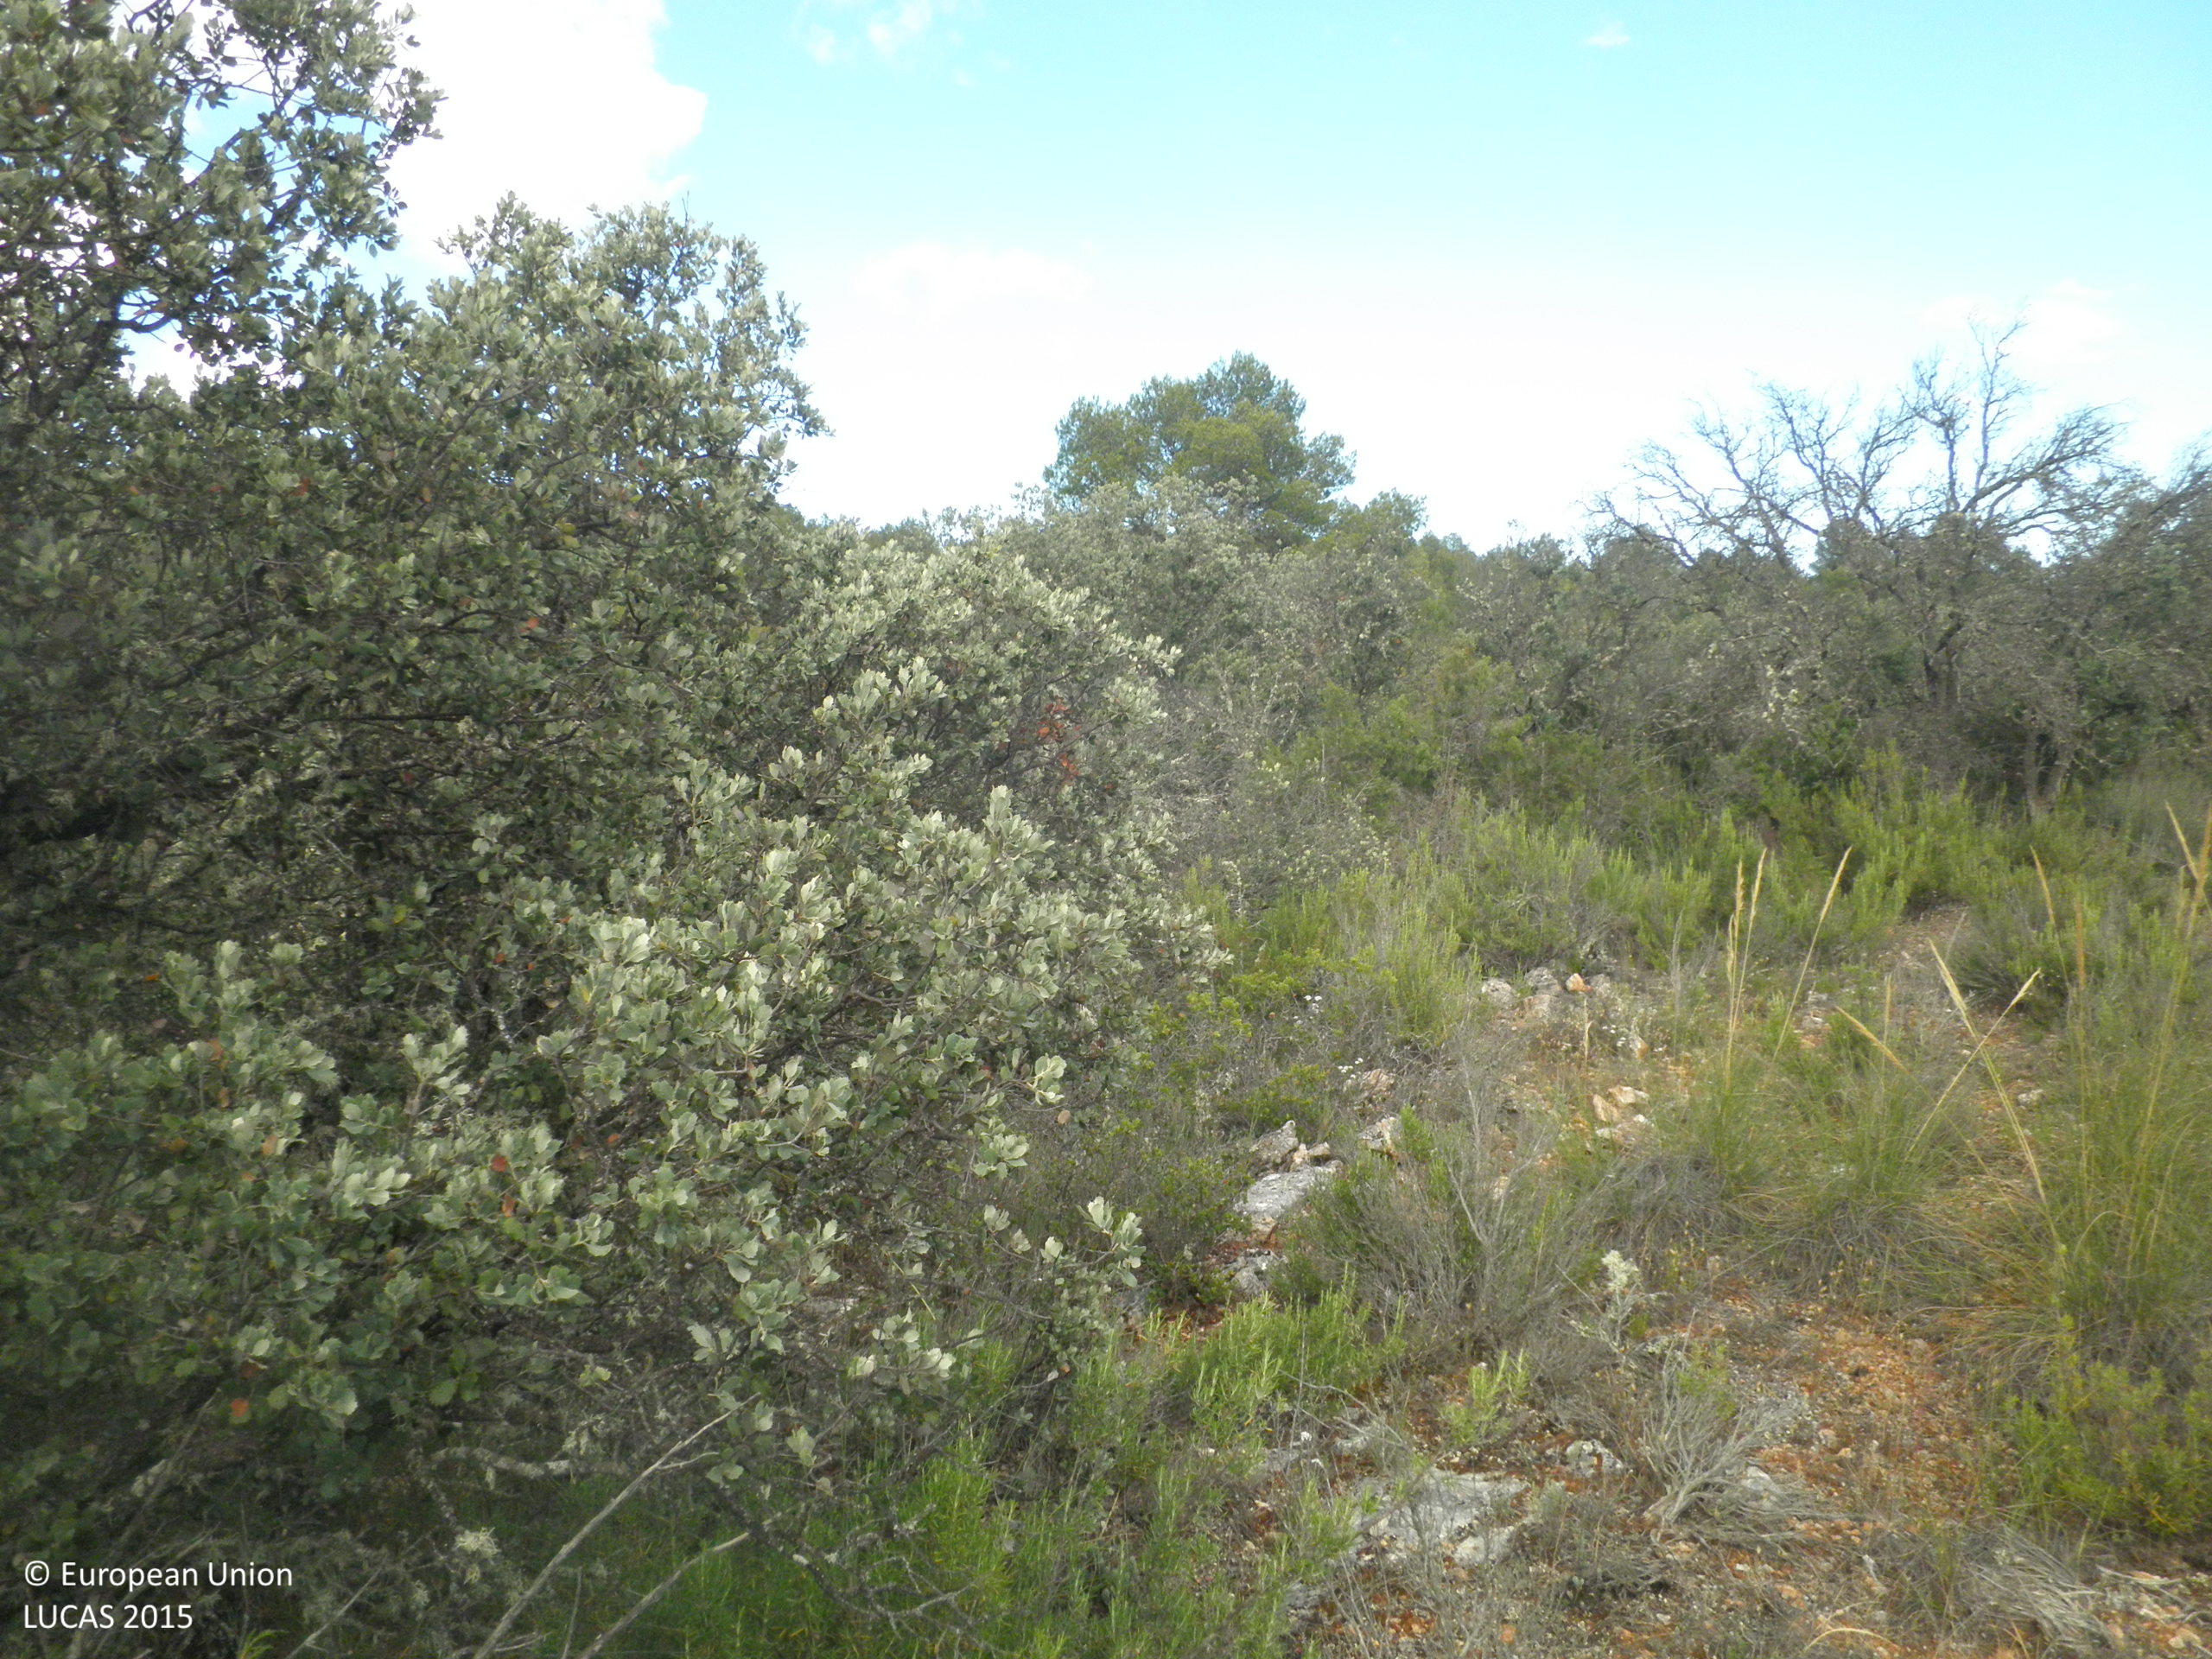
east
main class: Woodland
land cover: Broadleaved woodland
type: broadleaved evergreen forest
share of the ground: 10 - 25 %
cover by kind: shrubs 40 %, unconsolidated bare surface 30 %, broadleaved forest trees 20 %, herbaceous plants 10 %
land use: Semi-natural and natural areas not in use
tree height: < 5 m
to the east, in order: Broadleaved woodland; Pine dominated mixed woodland; Tracks; Pine dominated mixed woodland
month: June
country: ES
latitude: 39.7334
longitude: -1.6643
